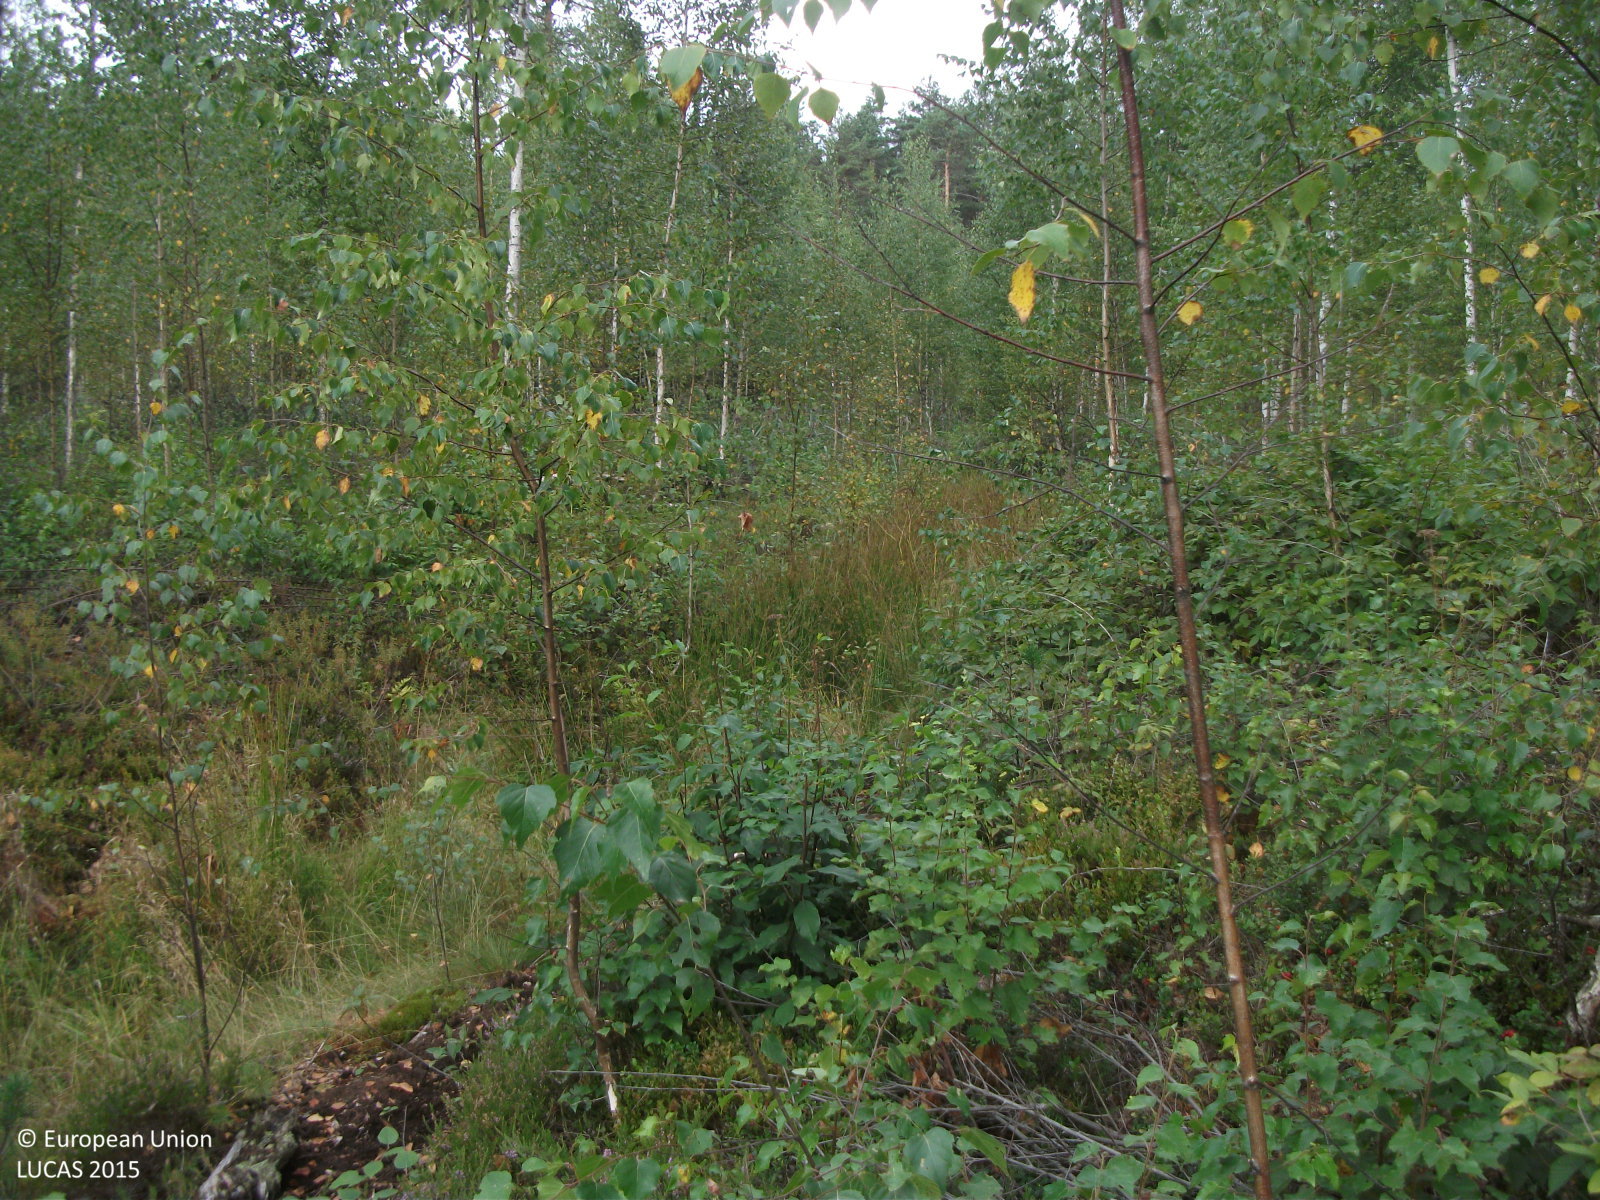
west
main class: Woodland
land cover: Broadleaved woodland
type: non-riverine alder, birch or aspen forest
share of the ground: 50 - 75 %
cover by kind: broadleaved forest trees 60 %, shrubs 20 %, herbaceous plants 10 %, lichens and mosses 10 %
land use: Forestry
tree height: < 5 m
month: September
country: LV
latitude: 56.5639
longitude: 26.2001
